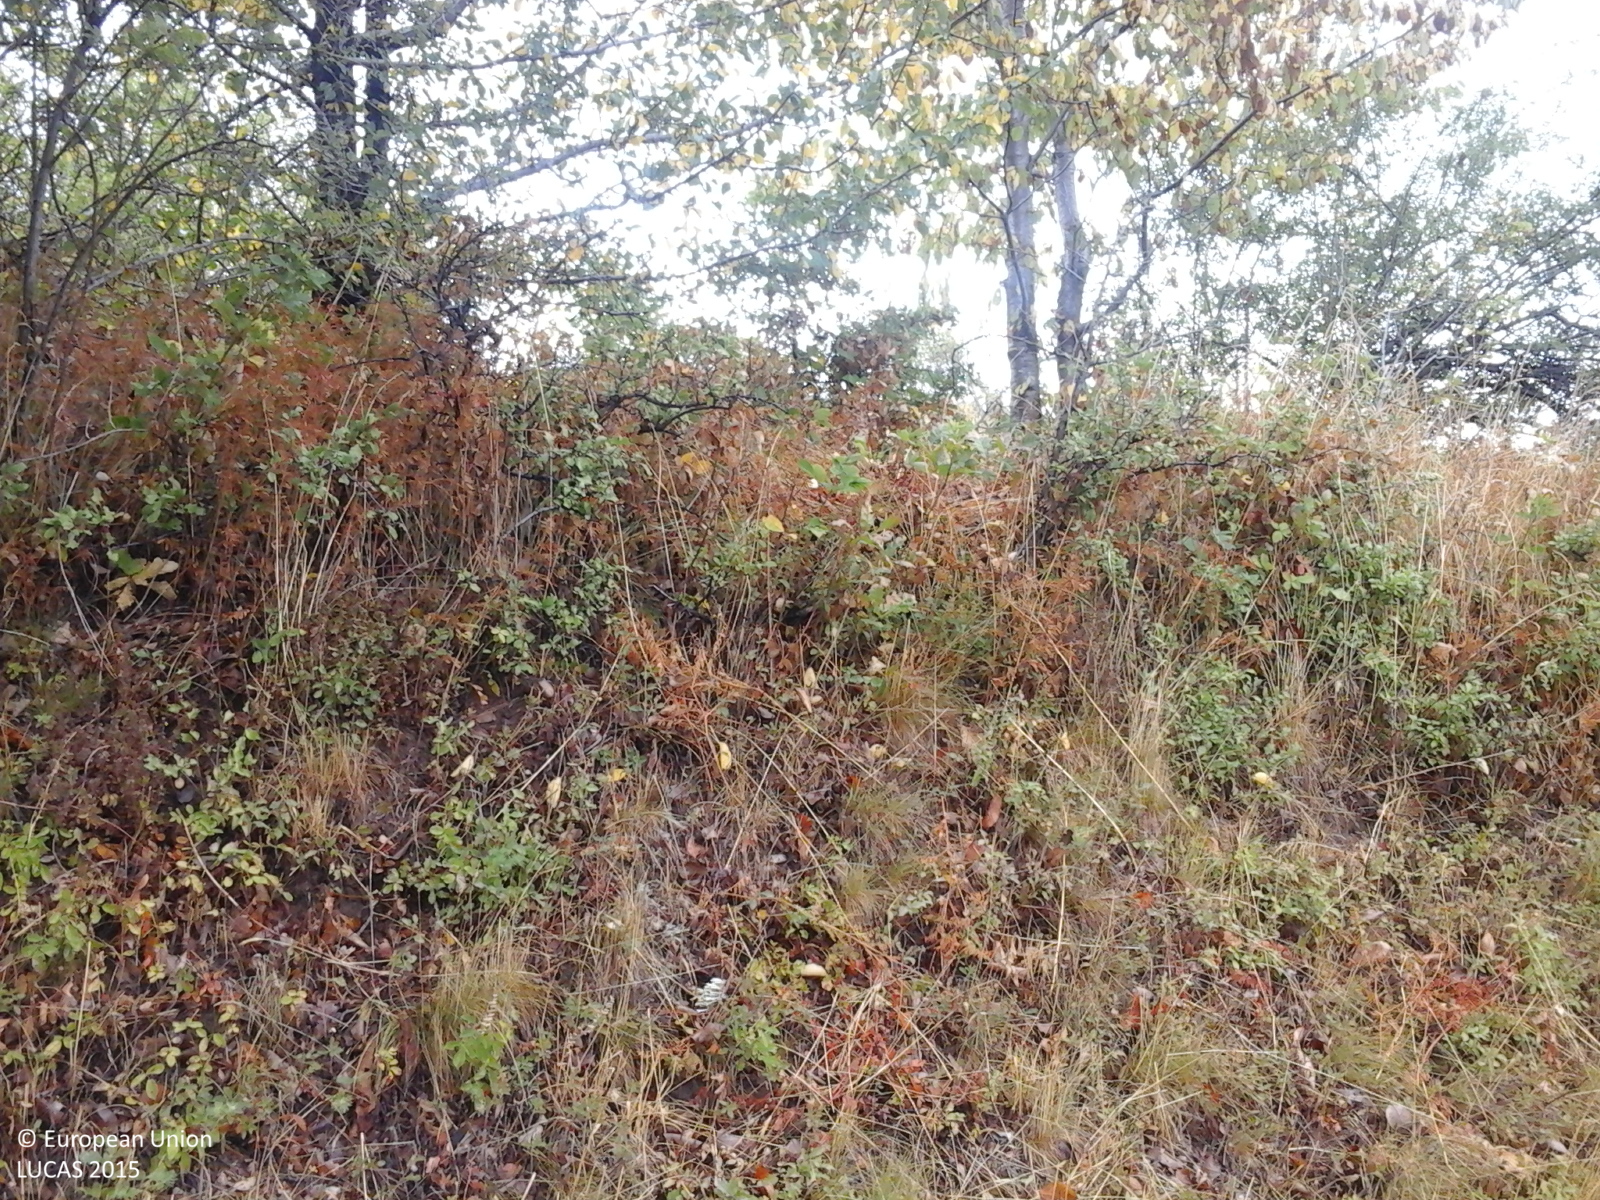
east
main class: Grassland
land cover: Grassland with sparse tree/shrub cover
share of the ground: > 75 %
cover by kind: herbaceous plants 85 %, shrubs 10 %, broadleaved forest trees 5 %
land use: Agriculture (excluding fallow land and kitchen gardens)
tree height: > 5 m
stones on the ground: < 10 %
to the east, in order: Grassland with sparse tree/shrub cover; Shrubland without tree cover; Vineyards; Grassland with sparse tree/shrub cover; Tracks; Grassland with sparse tree/shrub cover; Broadleaved woodland
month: August
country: RO
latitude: 44.7952
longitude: 22.6456
